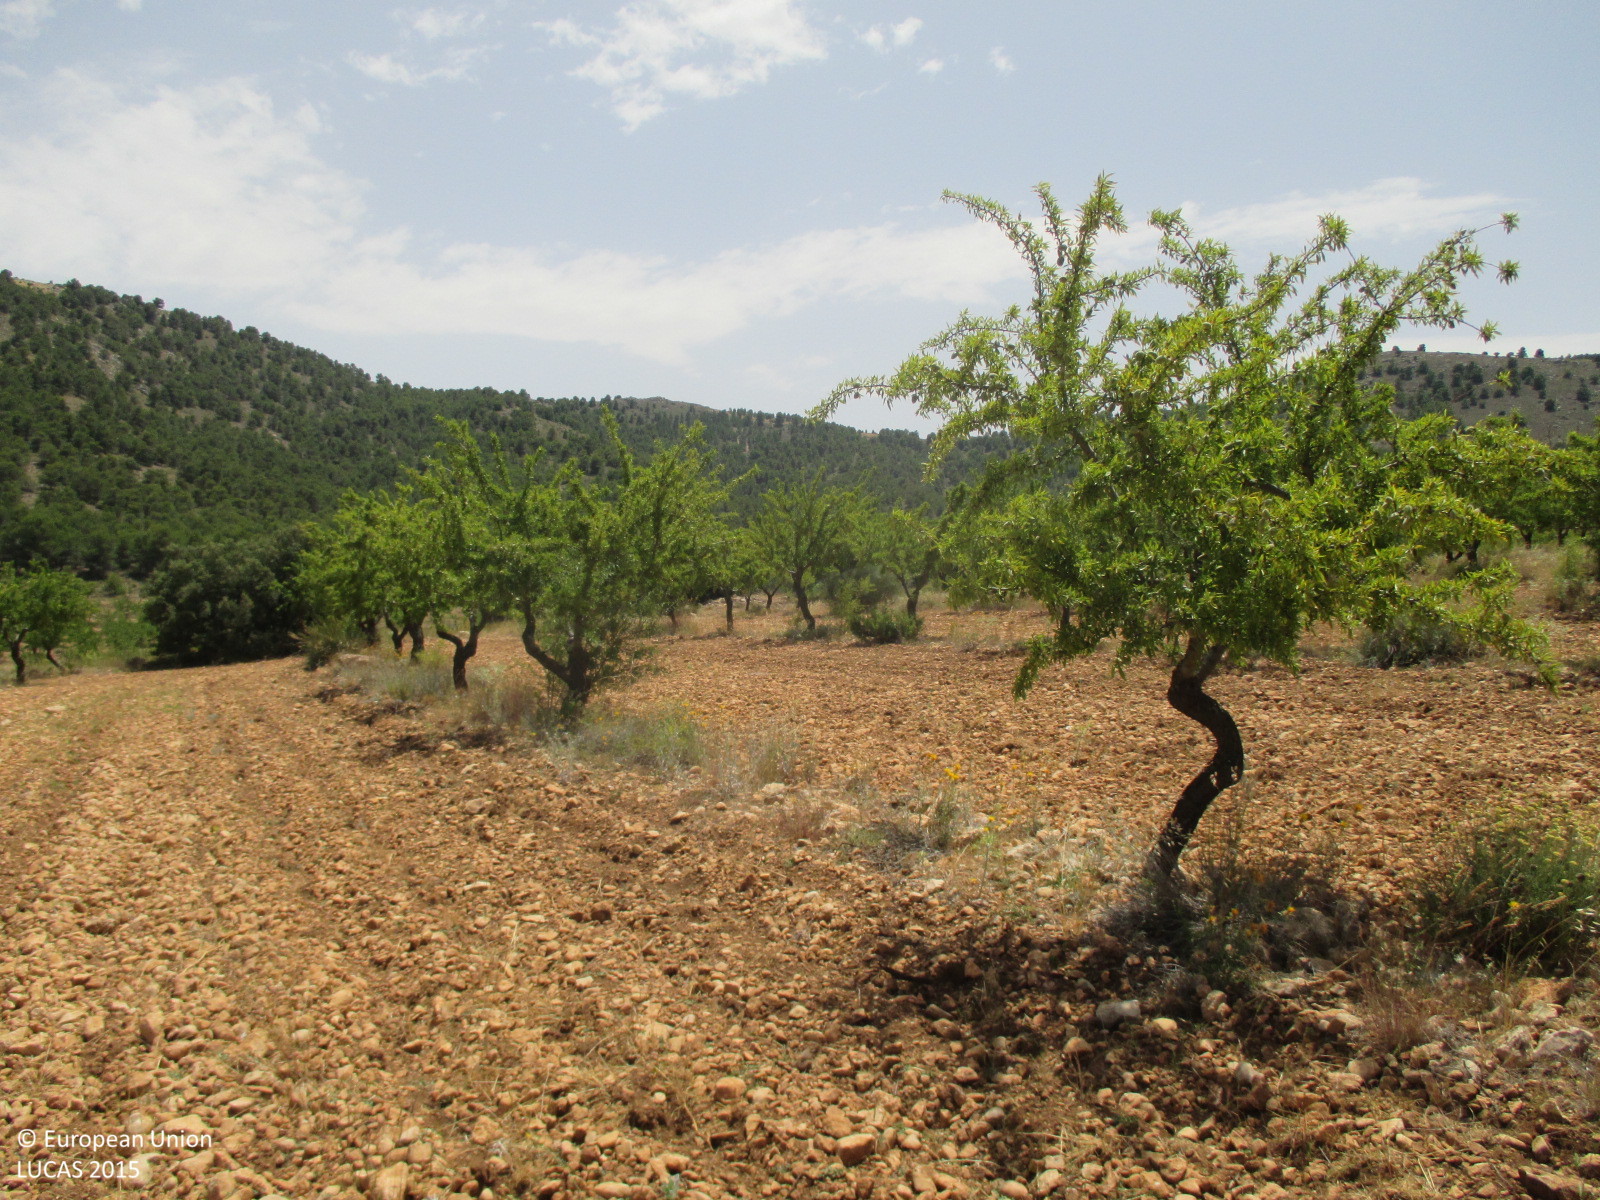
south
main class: Cropland
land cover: Nuts trees
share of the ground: 10 - 25 %
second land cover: Other bare soil
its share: > 75 %
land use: Agriculture (excluding fallow land and kitchen gardens)
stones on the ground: < 10 %
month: June
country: ES
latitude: 37.6596
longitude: -2.4450
